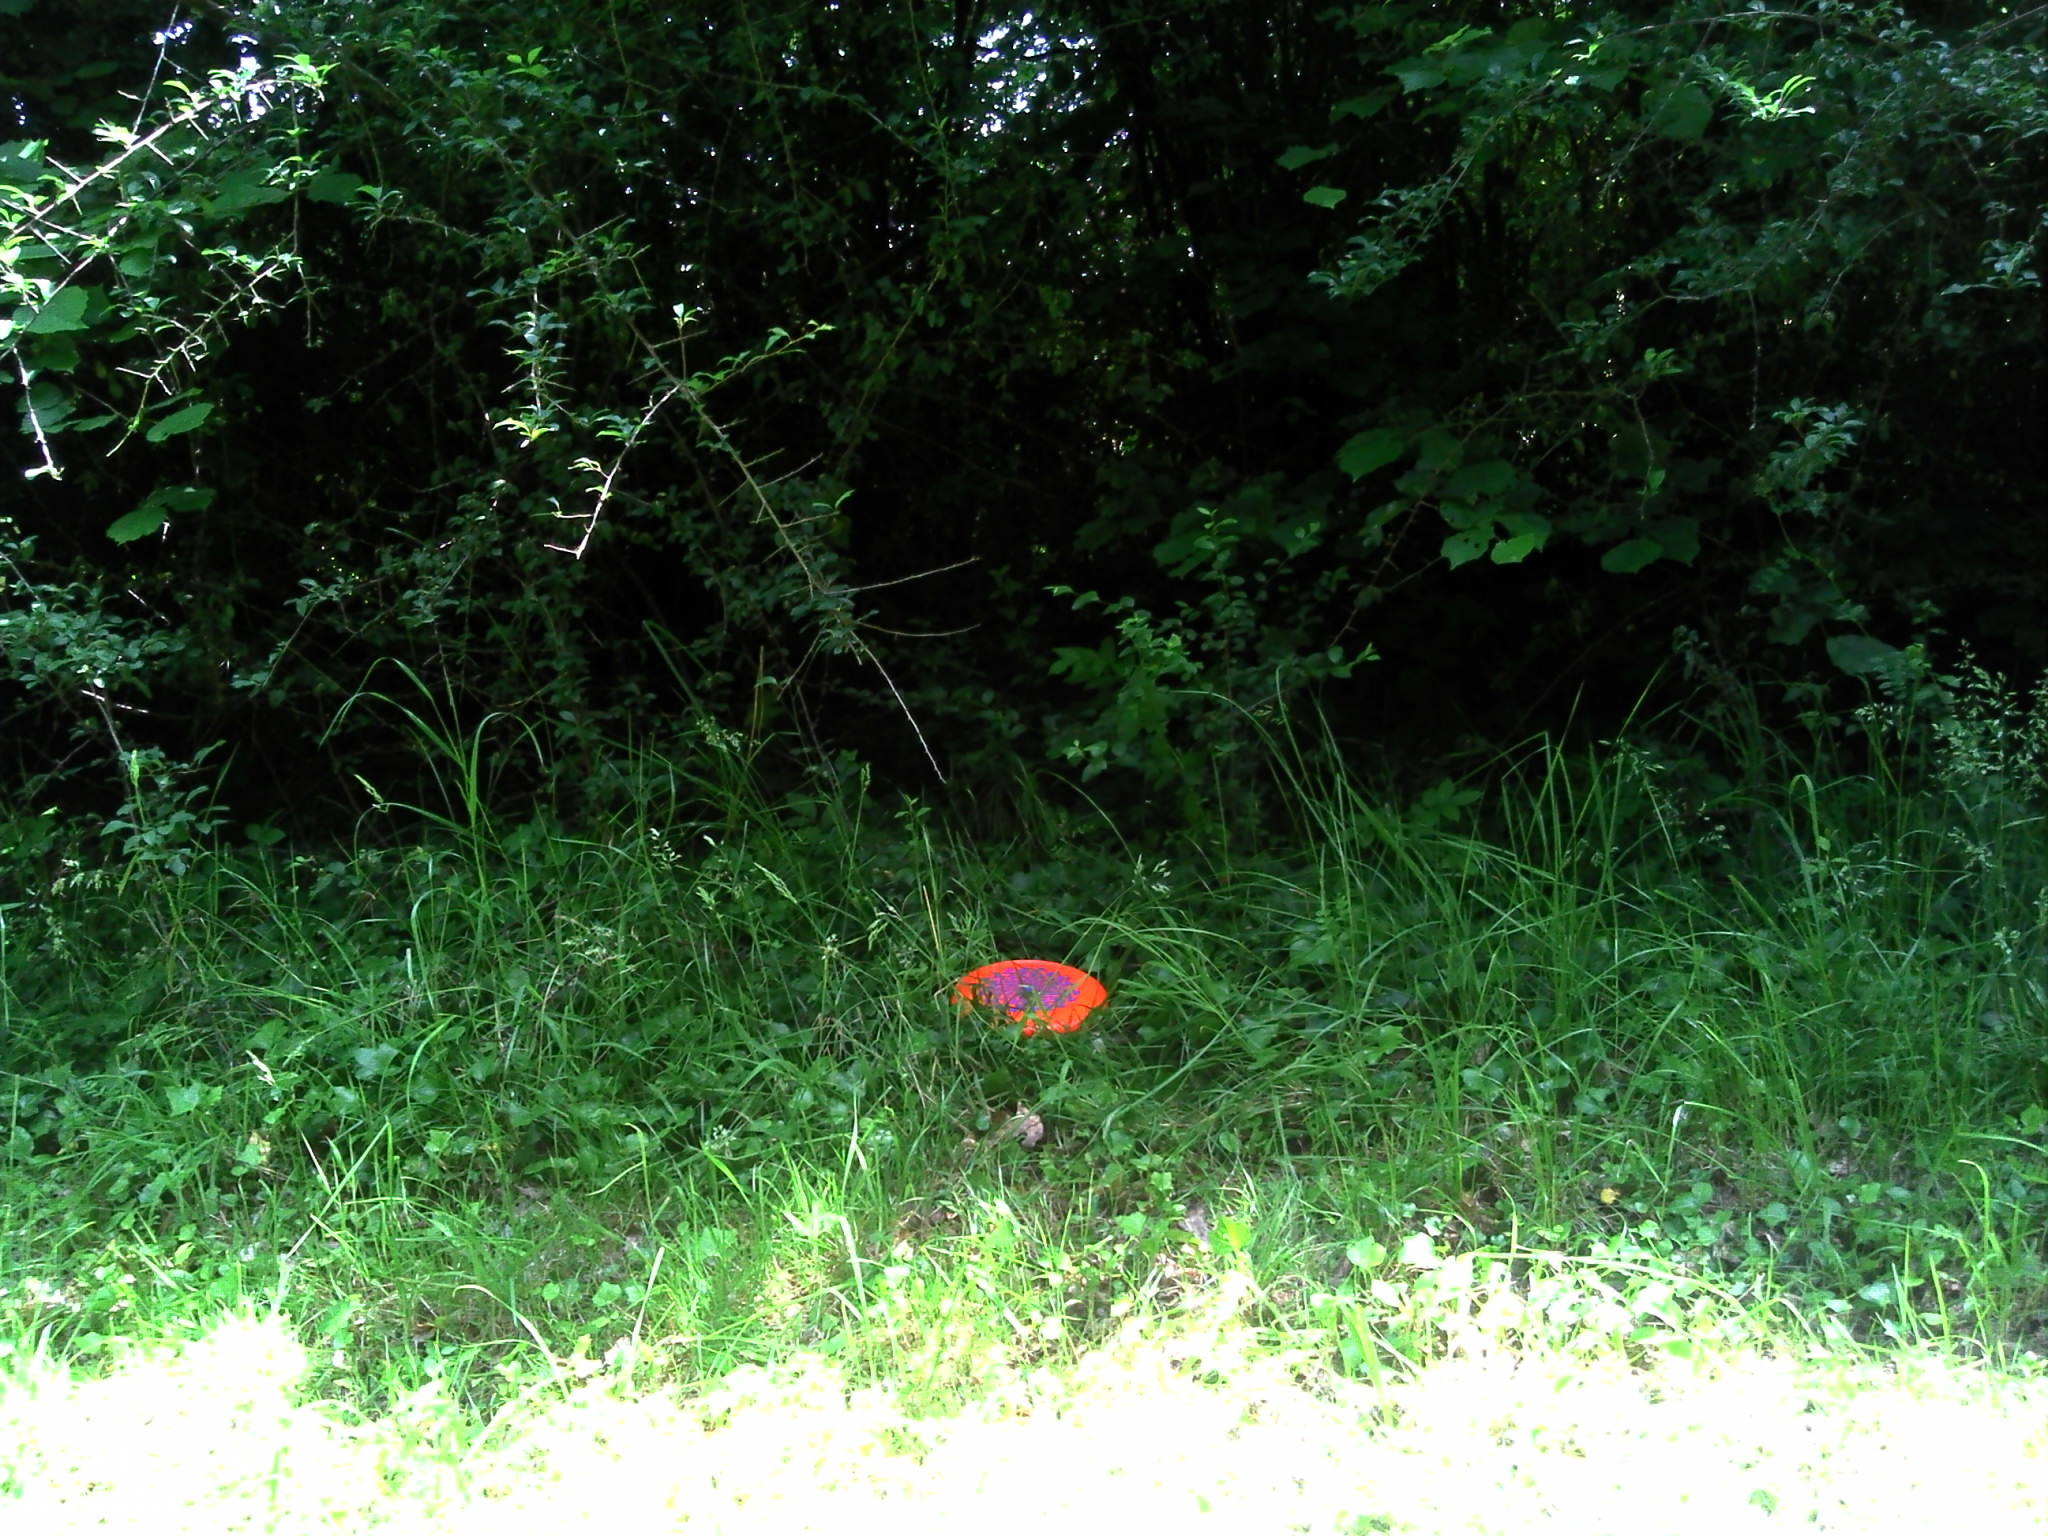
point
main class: Woodland
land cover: Broadleaved woodland
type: mesophytic deciduous forest
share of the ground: > 75 %
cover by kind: broadleaved forest trees 95 %, lichens and mosses 5 %
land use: Forestry
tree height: > 5 m
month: June
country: FR
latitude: 48.5938
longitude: 0.1141
